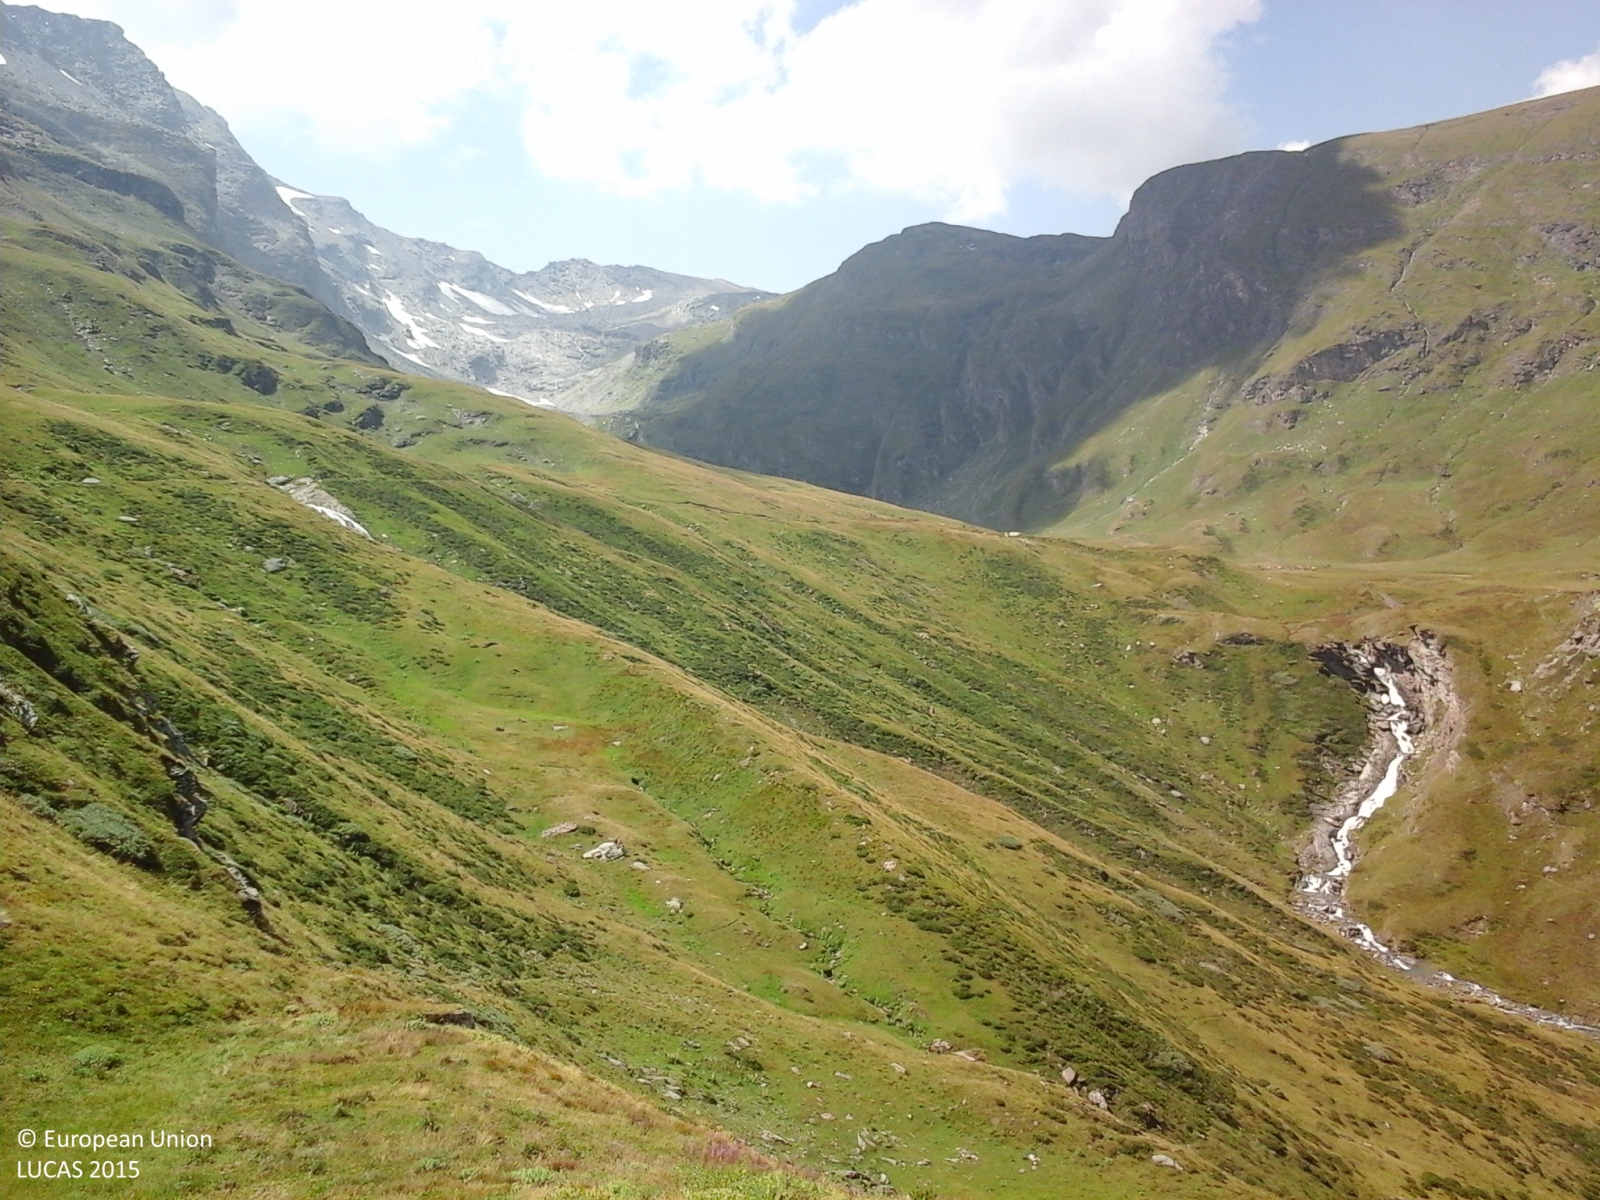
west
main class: Grassland
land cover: Grassland without tree/shrub cover
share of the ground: > 75 %
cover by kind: herbaceous plants 100 %
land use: Agriculture (excluding fallow land and kitchen gardens)
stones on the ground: < 10 %
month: August
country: IT
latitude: 45.6023
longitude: 7.5548
